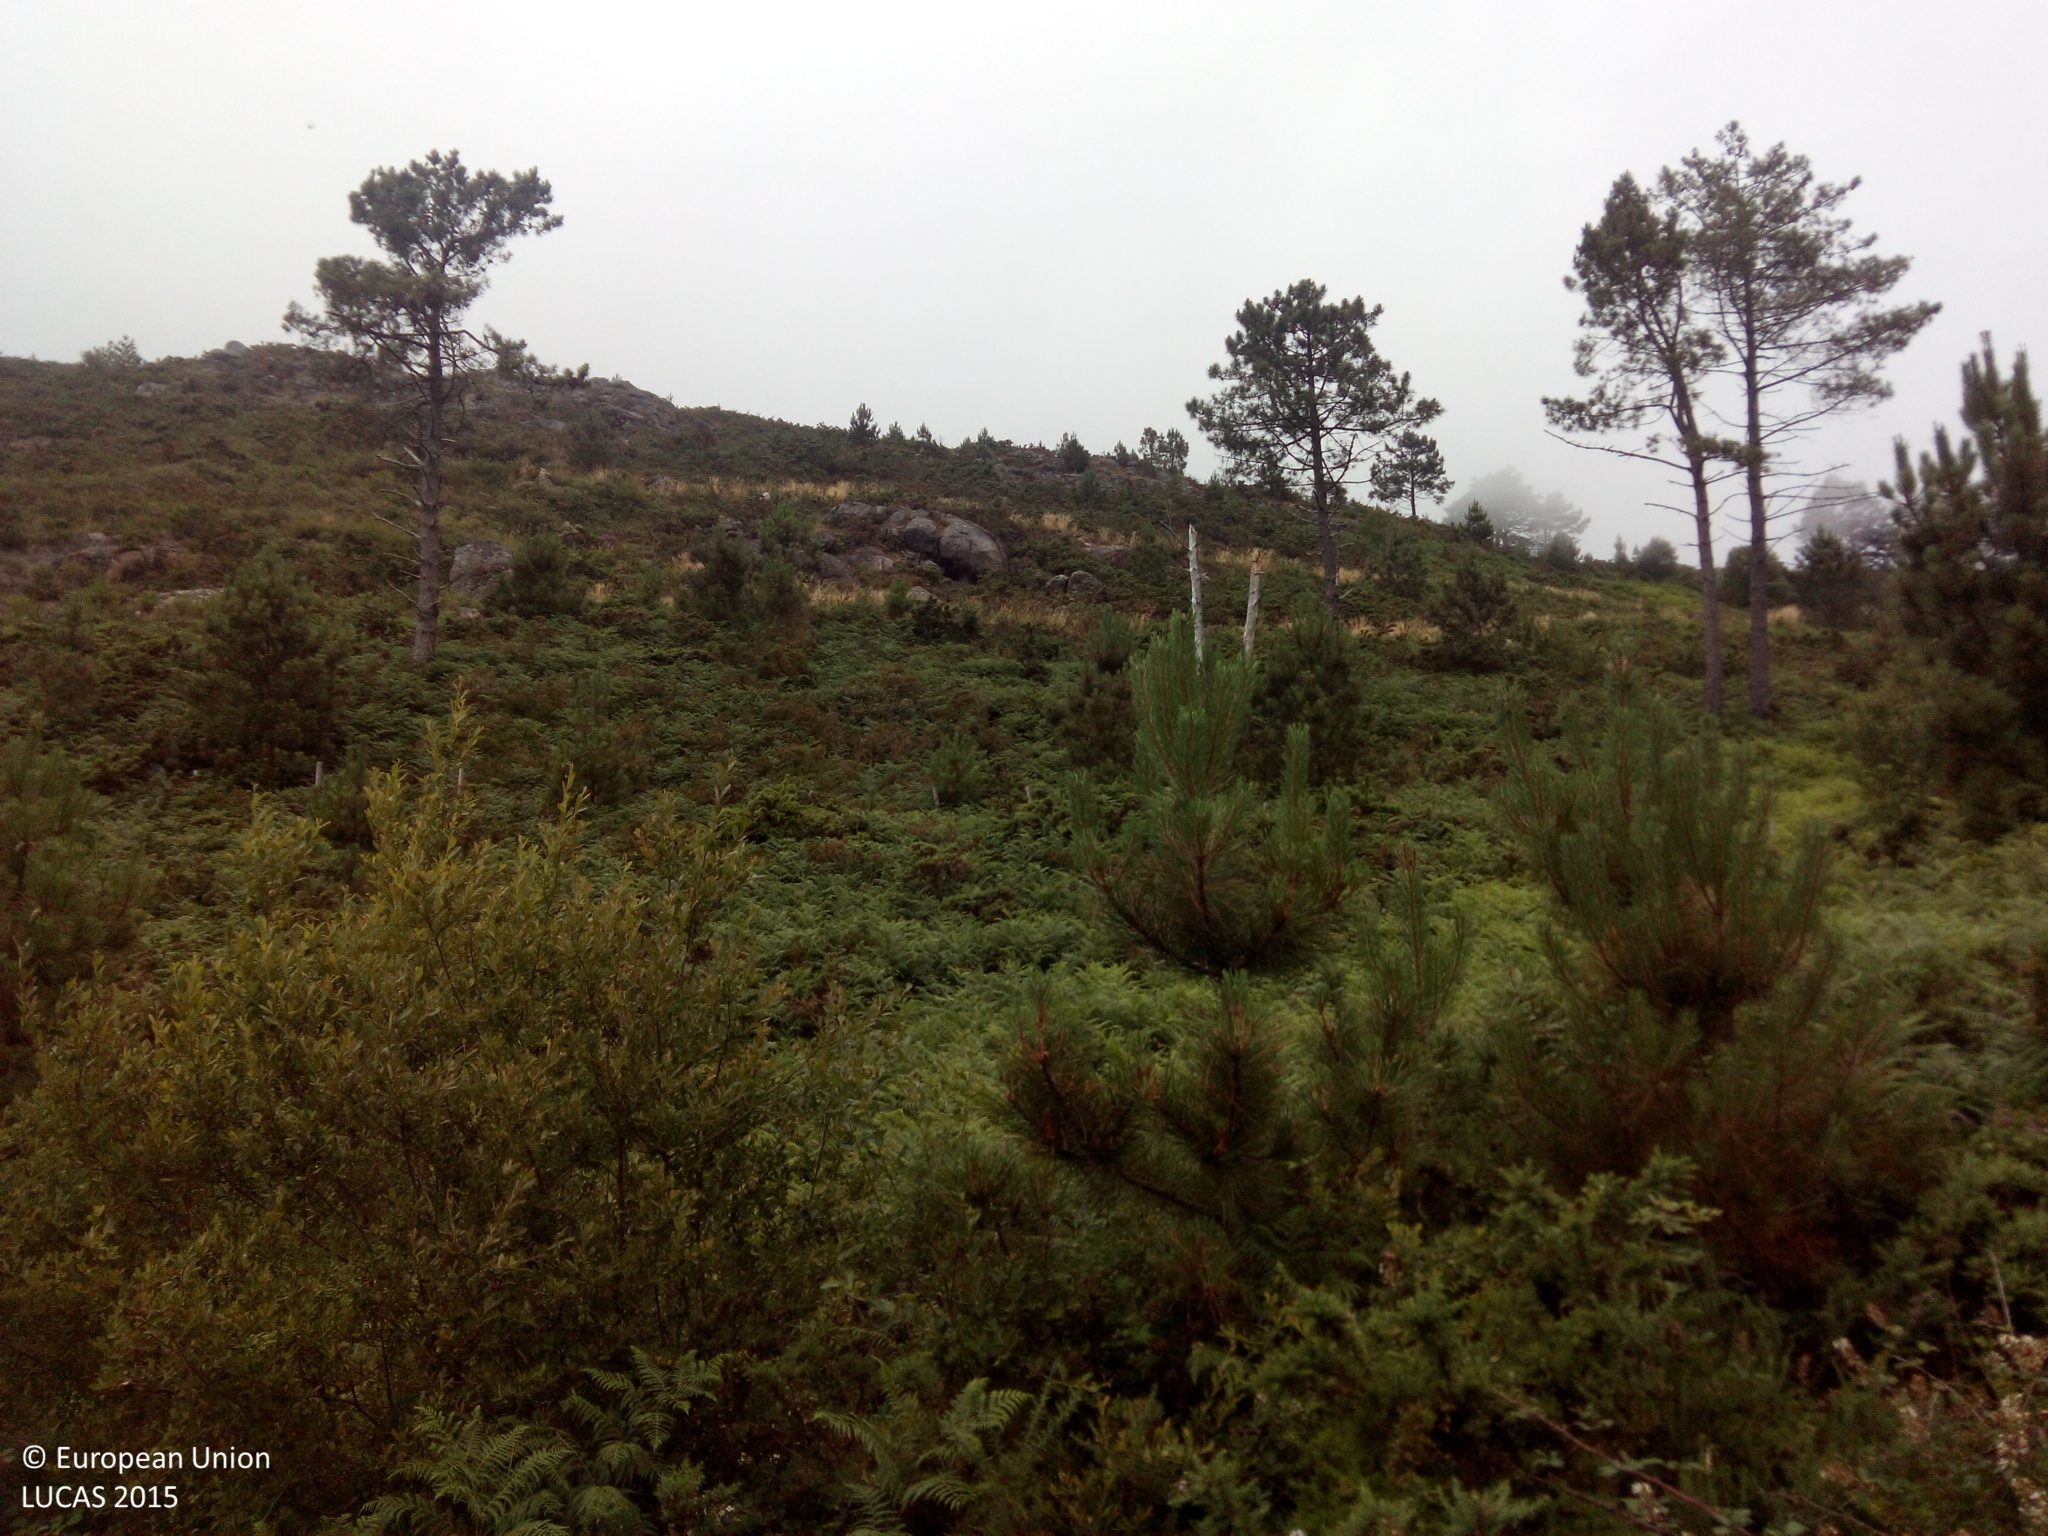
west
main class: Shrubland
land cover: Shrubland with sparse tree cover
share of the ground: > 75 %
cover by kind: shrubs 95 %, coniferous forest trees 5 %
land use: Semi-natural and natural areas not in use
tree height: < 5 m
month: July
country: ES
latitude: 42.2349
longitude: -8.2510
